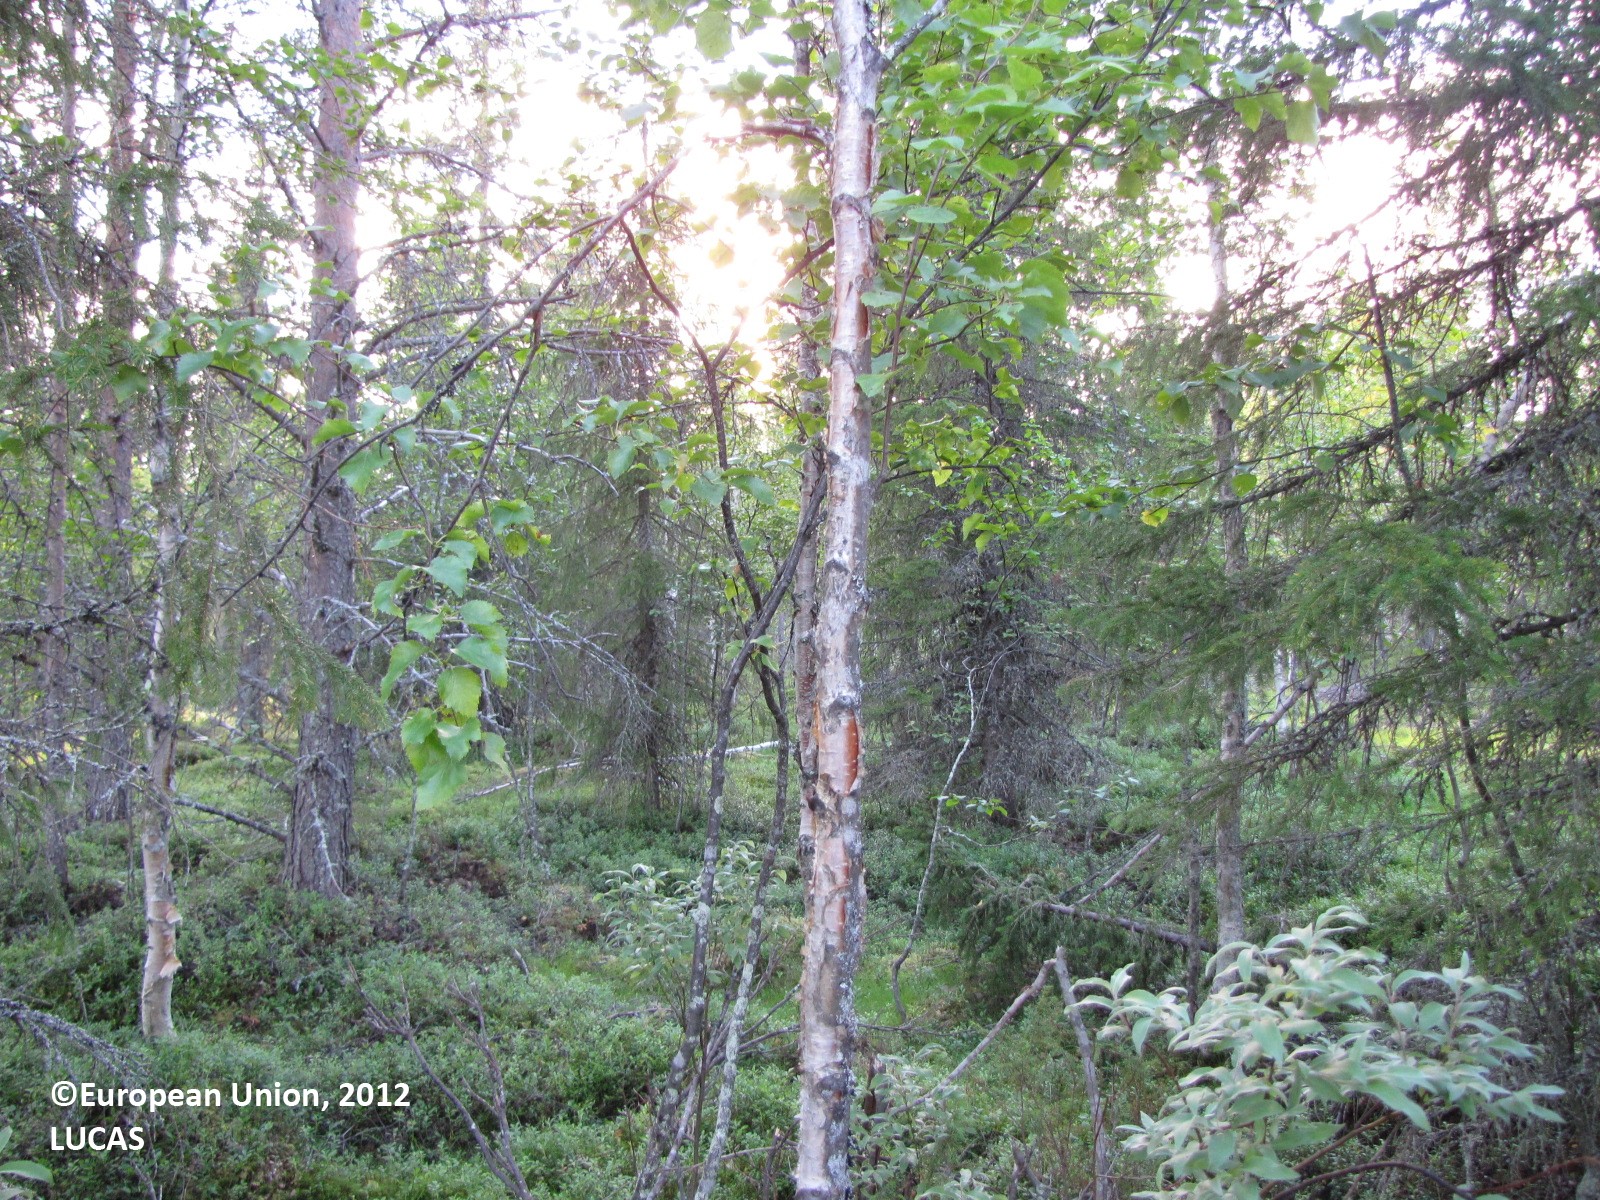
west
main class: Woodland
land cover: Spruce dominated mixed woodland
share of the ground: 25 - 50 %
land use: Forestry
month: August
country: FI
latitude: 66.8040
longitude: 24.9973
